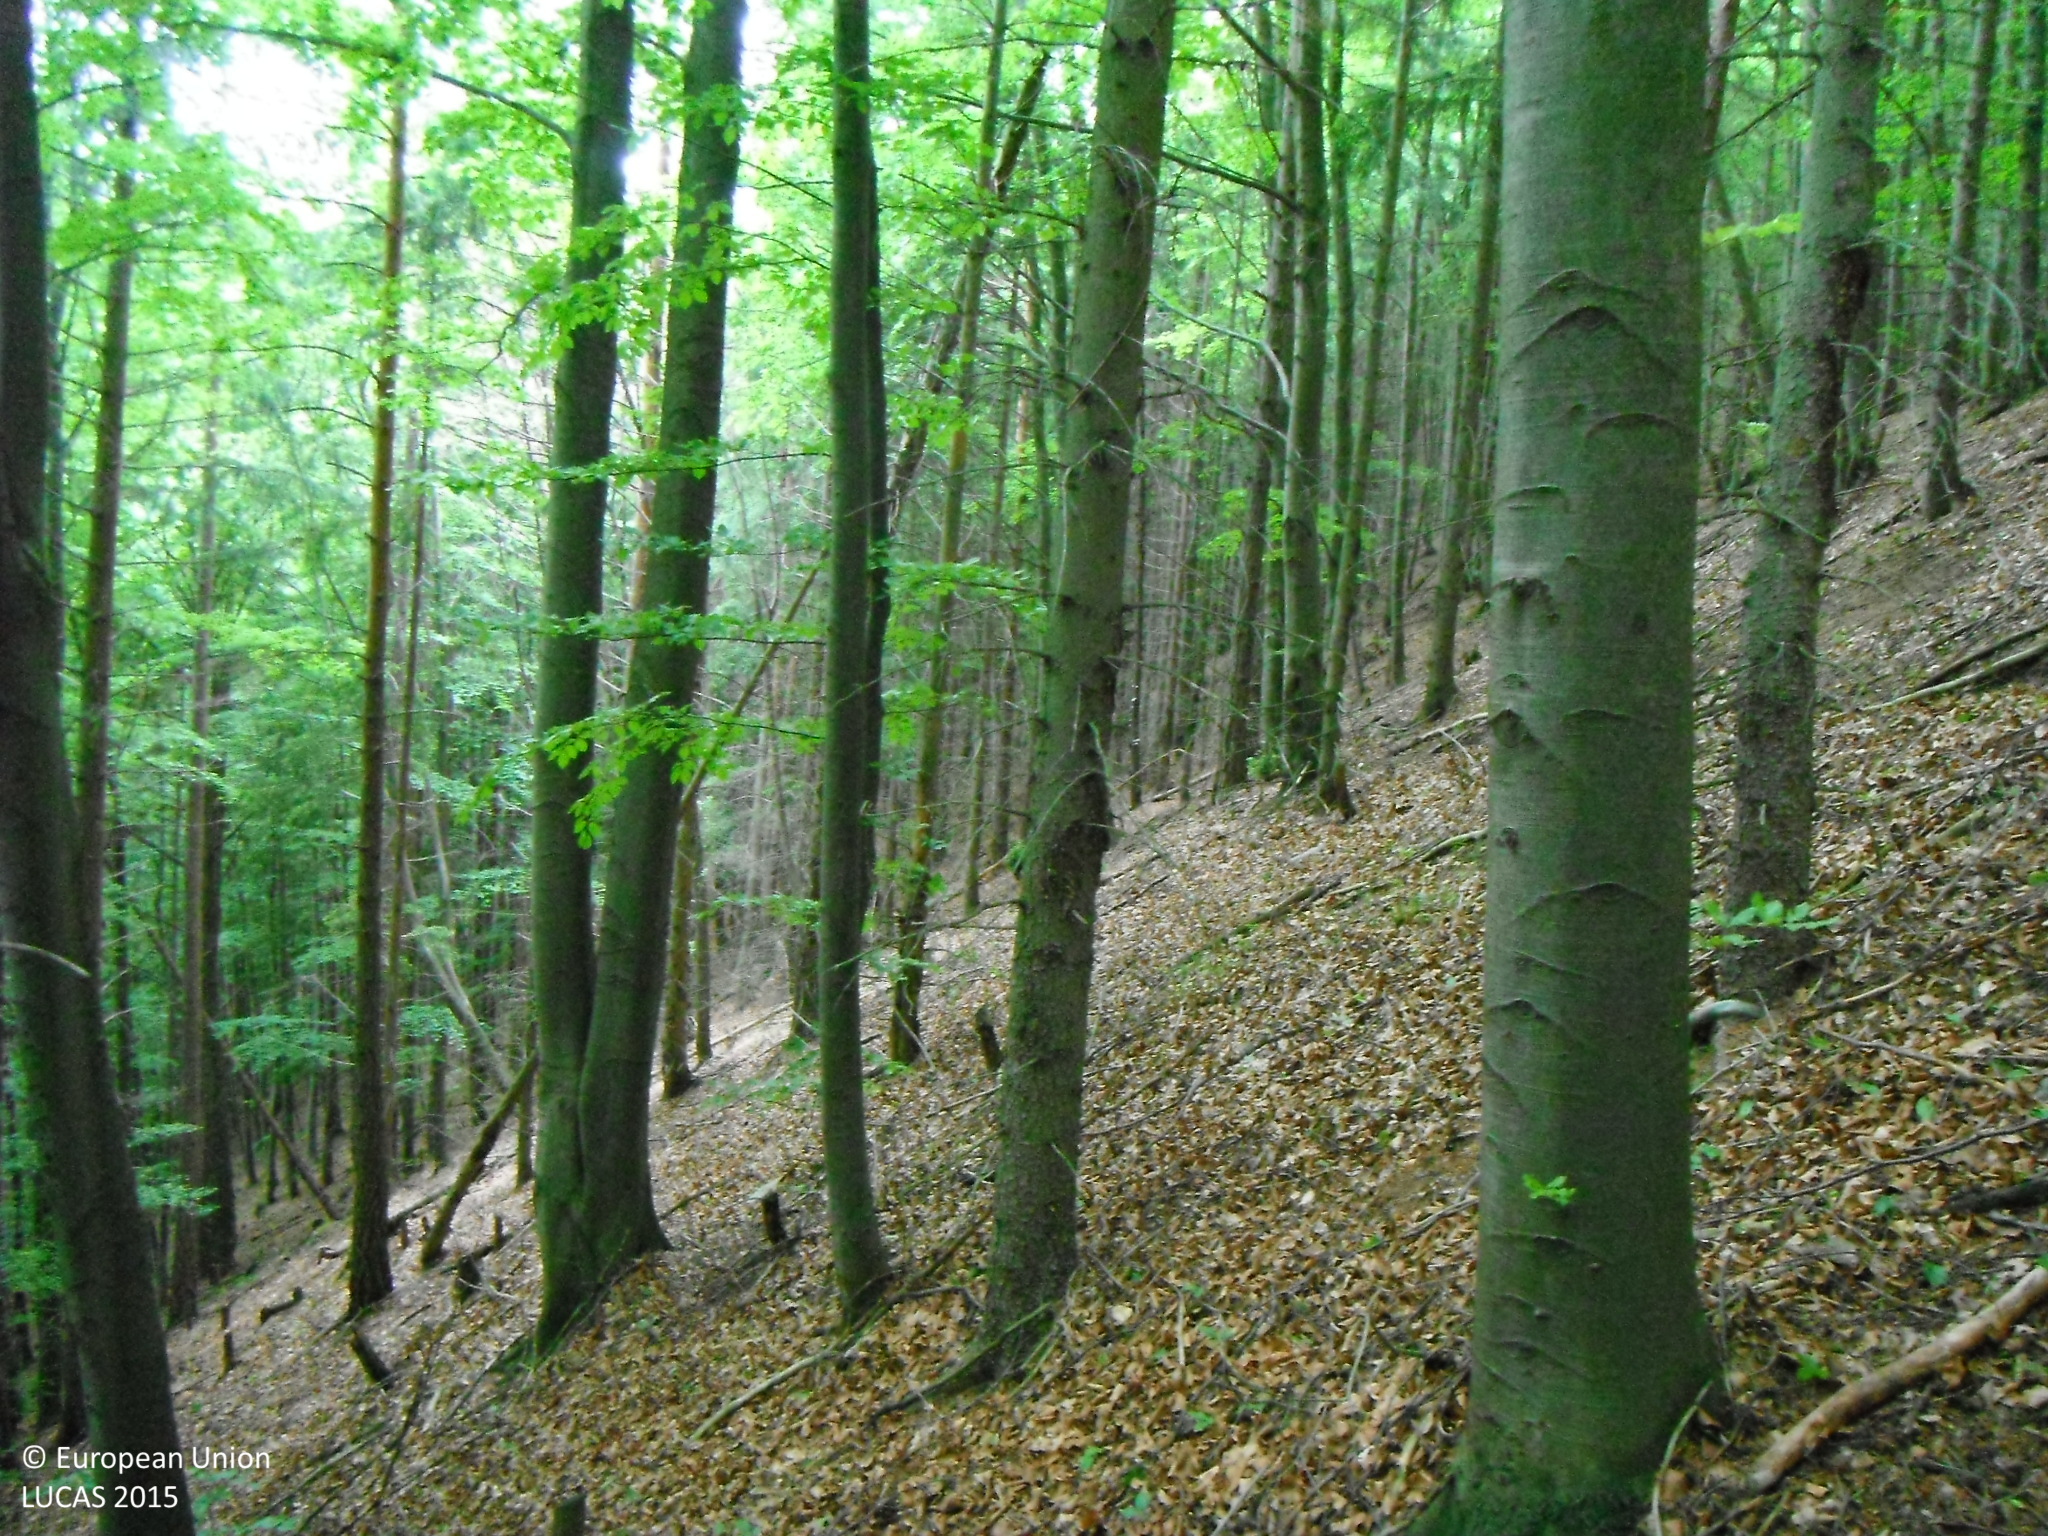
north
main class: Woodland
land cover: Spruce dominated mixed woodland
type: hemiboreal forest and nemoral coniferous forest and mixed broadleaved-coniferous forest
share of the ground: > 75 %
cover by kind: coniferous forest trees 50 %, broadleaved forest trees 50 %
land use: Forestry
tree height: > 5 m
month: May
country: SK
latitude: 48.9789
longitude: 18.7503
